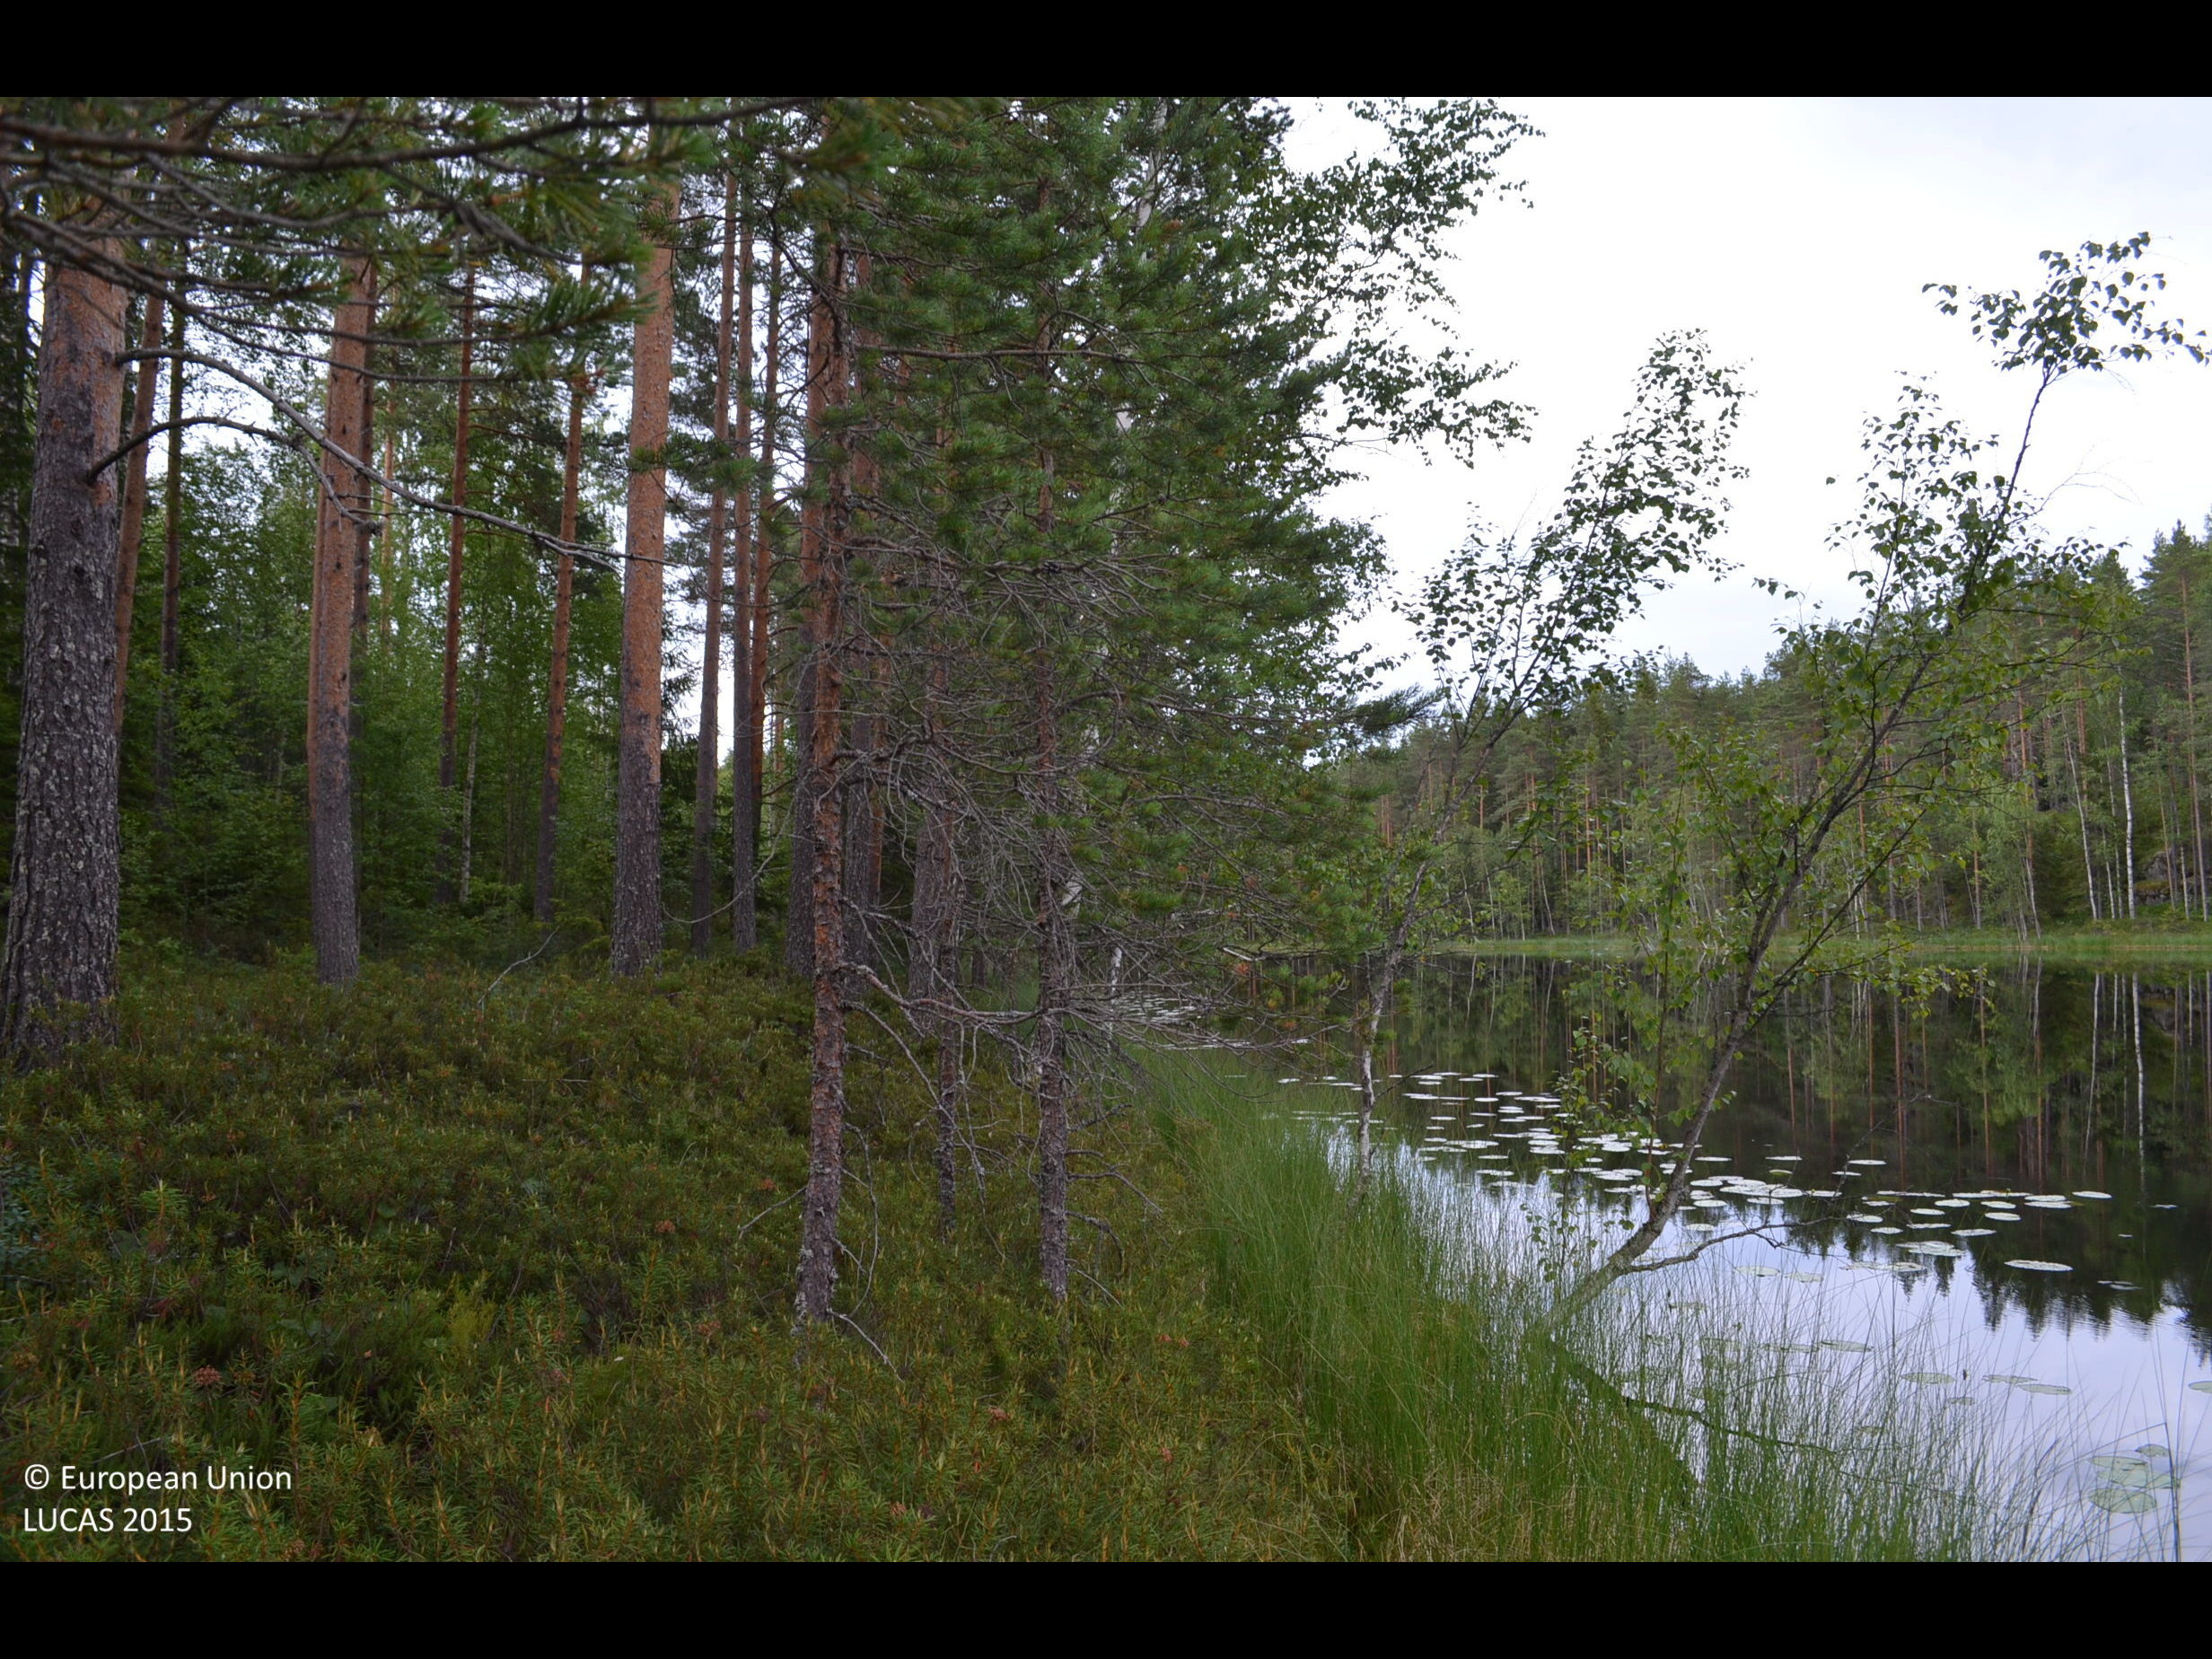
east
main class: Woodland
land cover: Pine dominated coniferous woodland
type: boreal forest
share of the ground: > 75 %
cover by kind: coniferous forest trees 65 %, shrubs 25 %, broadleaved forest trees 10 %
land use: Forestry
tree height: > 5 m
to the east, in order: Pine dominated coniferous woodland; Pine dominated mixed woodland; Other mixed woodland
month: July
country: FI
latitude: 62.0294
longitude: 23.9783
